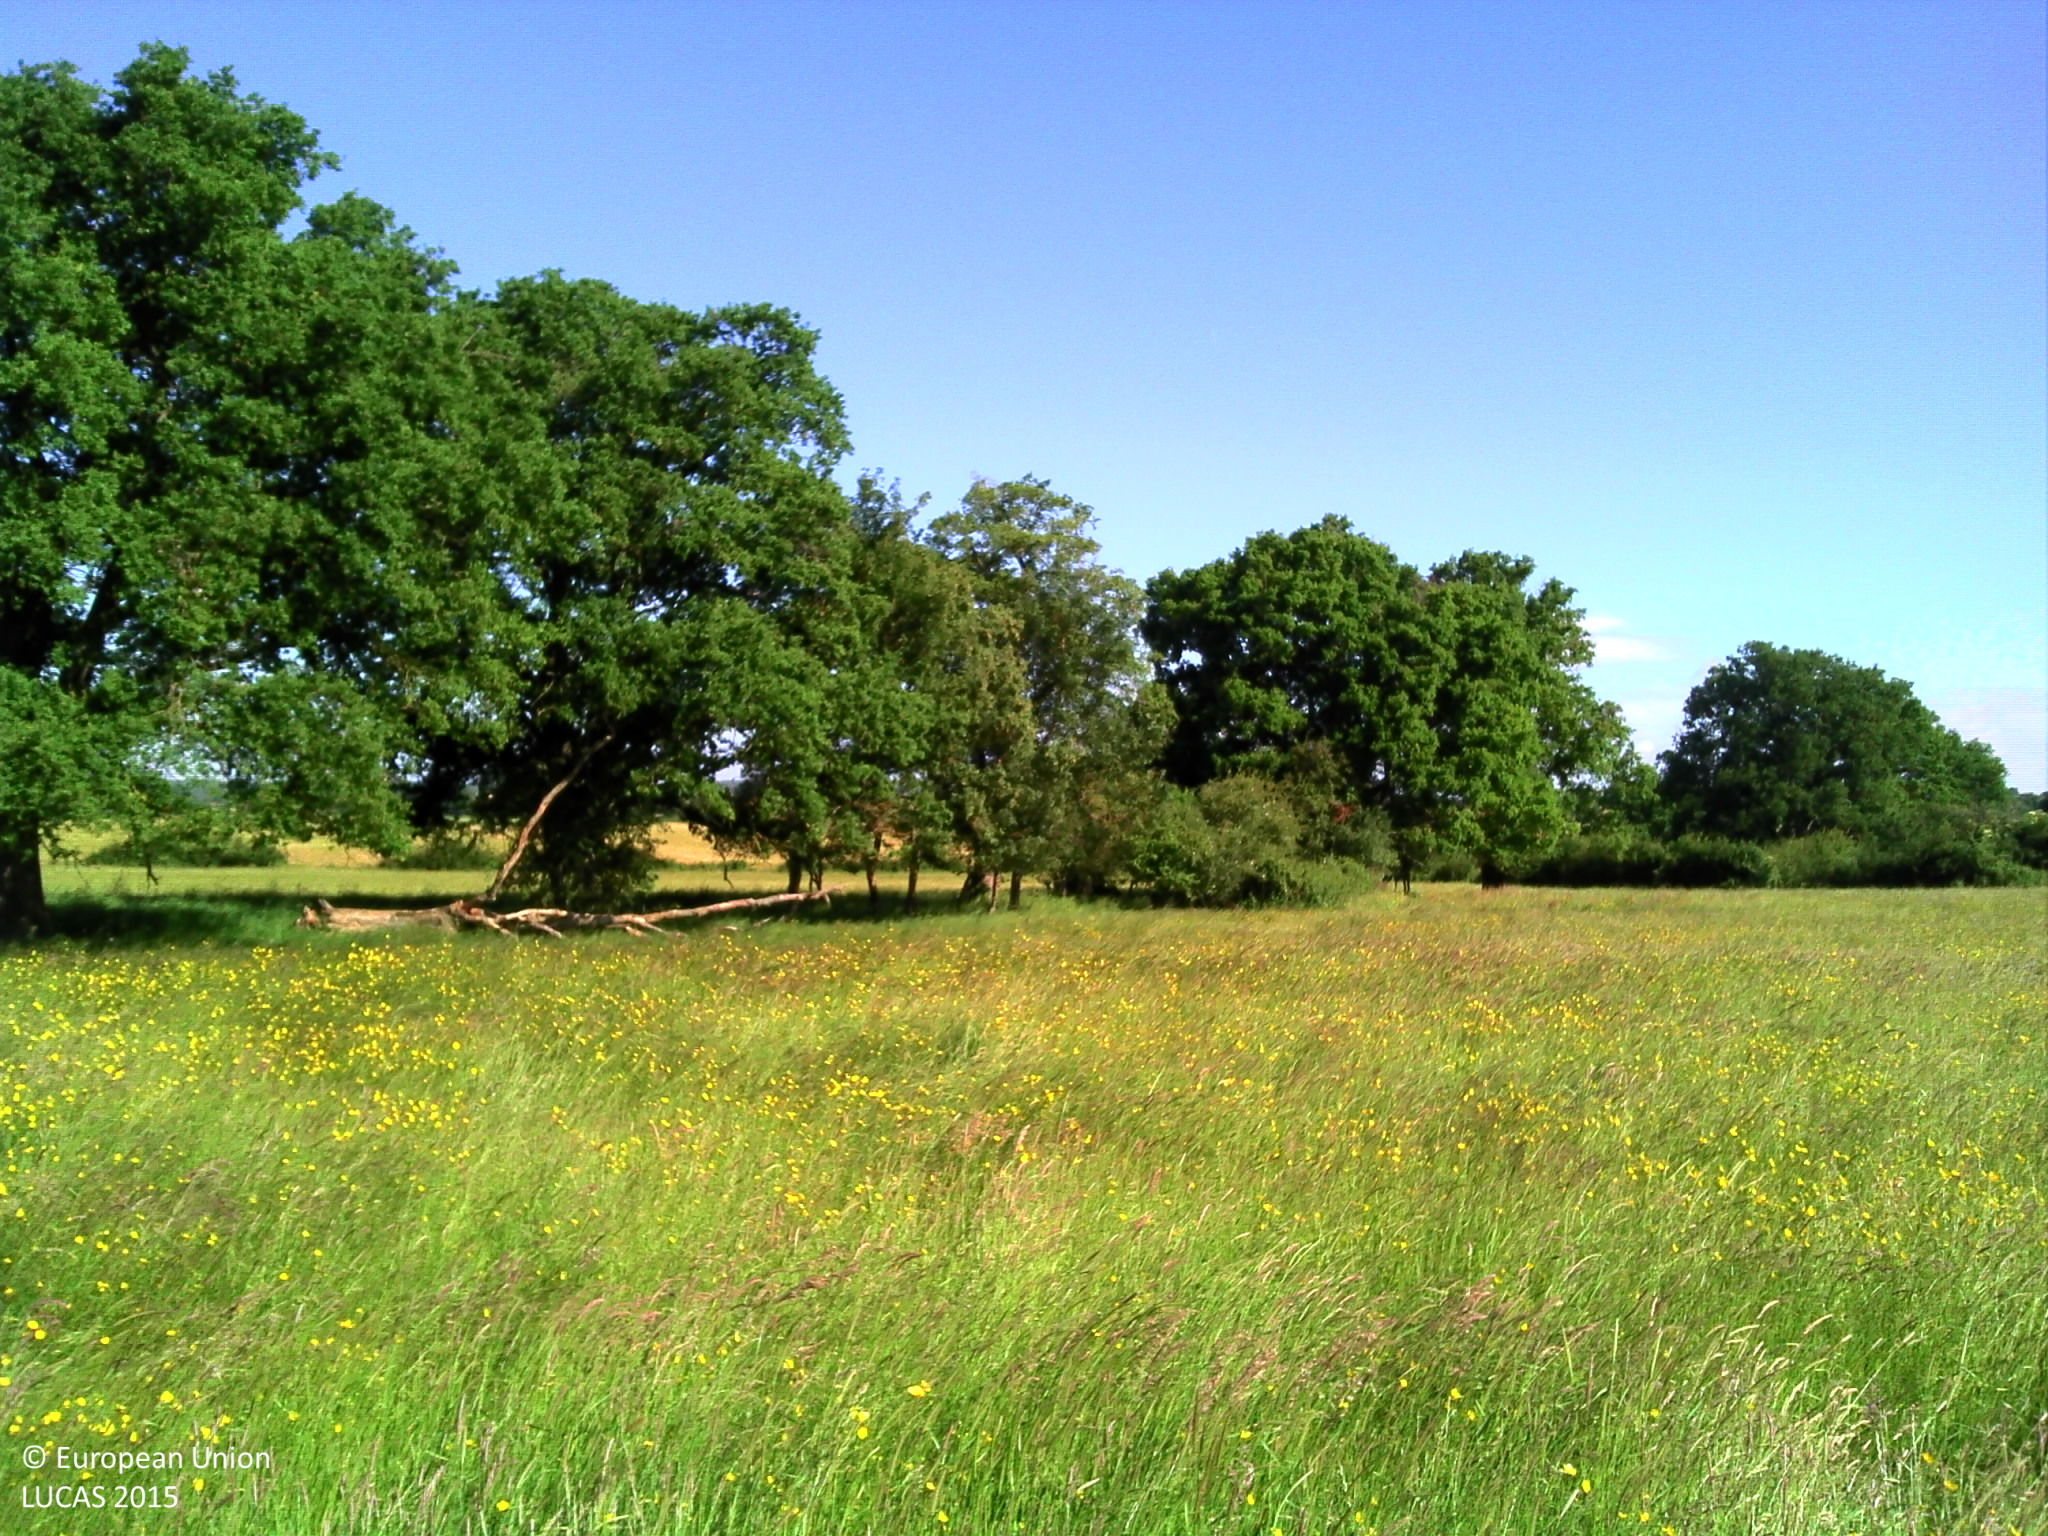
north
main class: Grassland
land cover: Grassland without tree/shrub cover
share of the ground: > 75 %
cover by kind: herbaceous plants 100 %
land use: Agriculture (excluding fallow land and kitchen gardens)
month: June
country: FR
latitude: 46.9654
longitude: 2.9115
